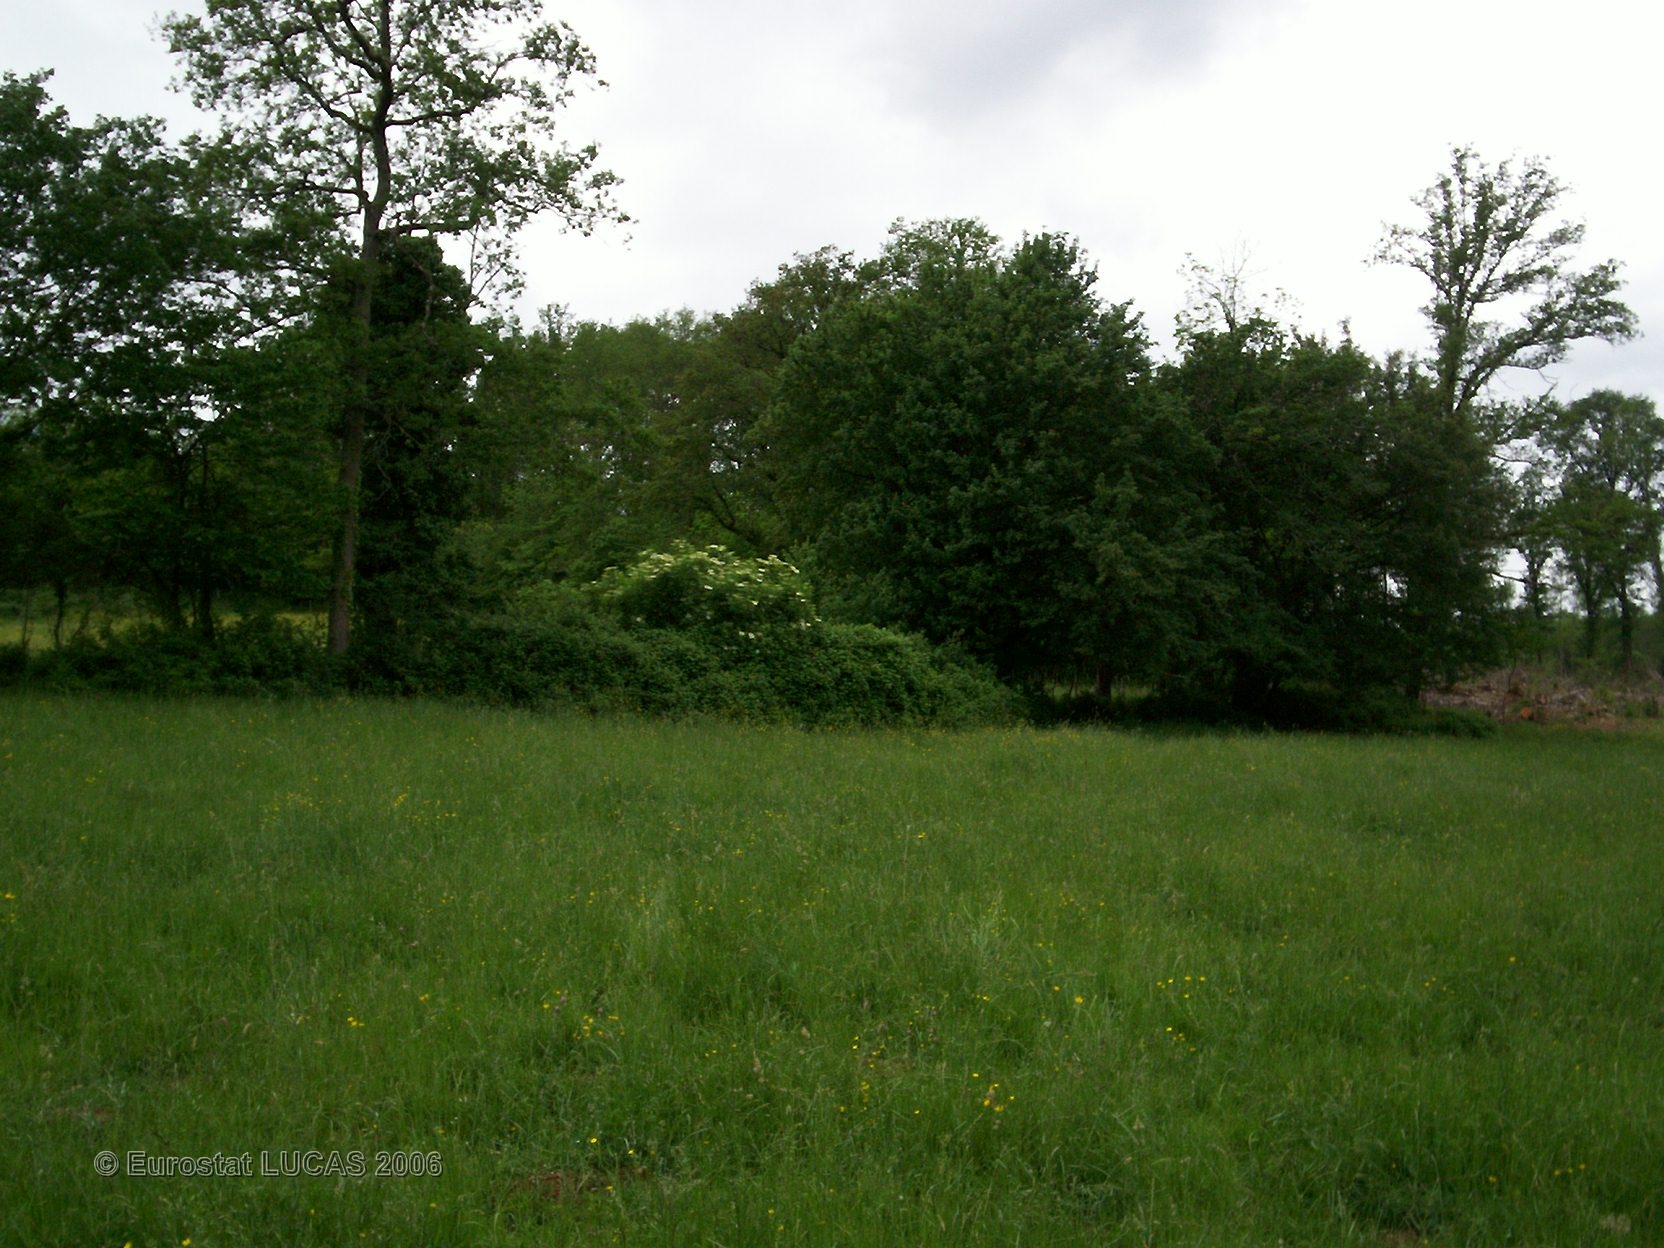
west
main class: Grassland
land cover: Grassland without tree/shrub cover
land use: Agriculture (excluding fallow land and kitchen gardens)
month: May
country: FR
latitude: 45.8210
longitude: 0.5255
